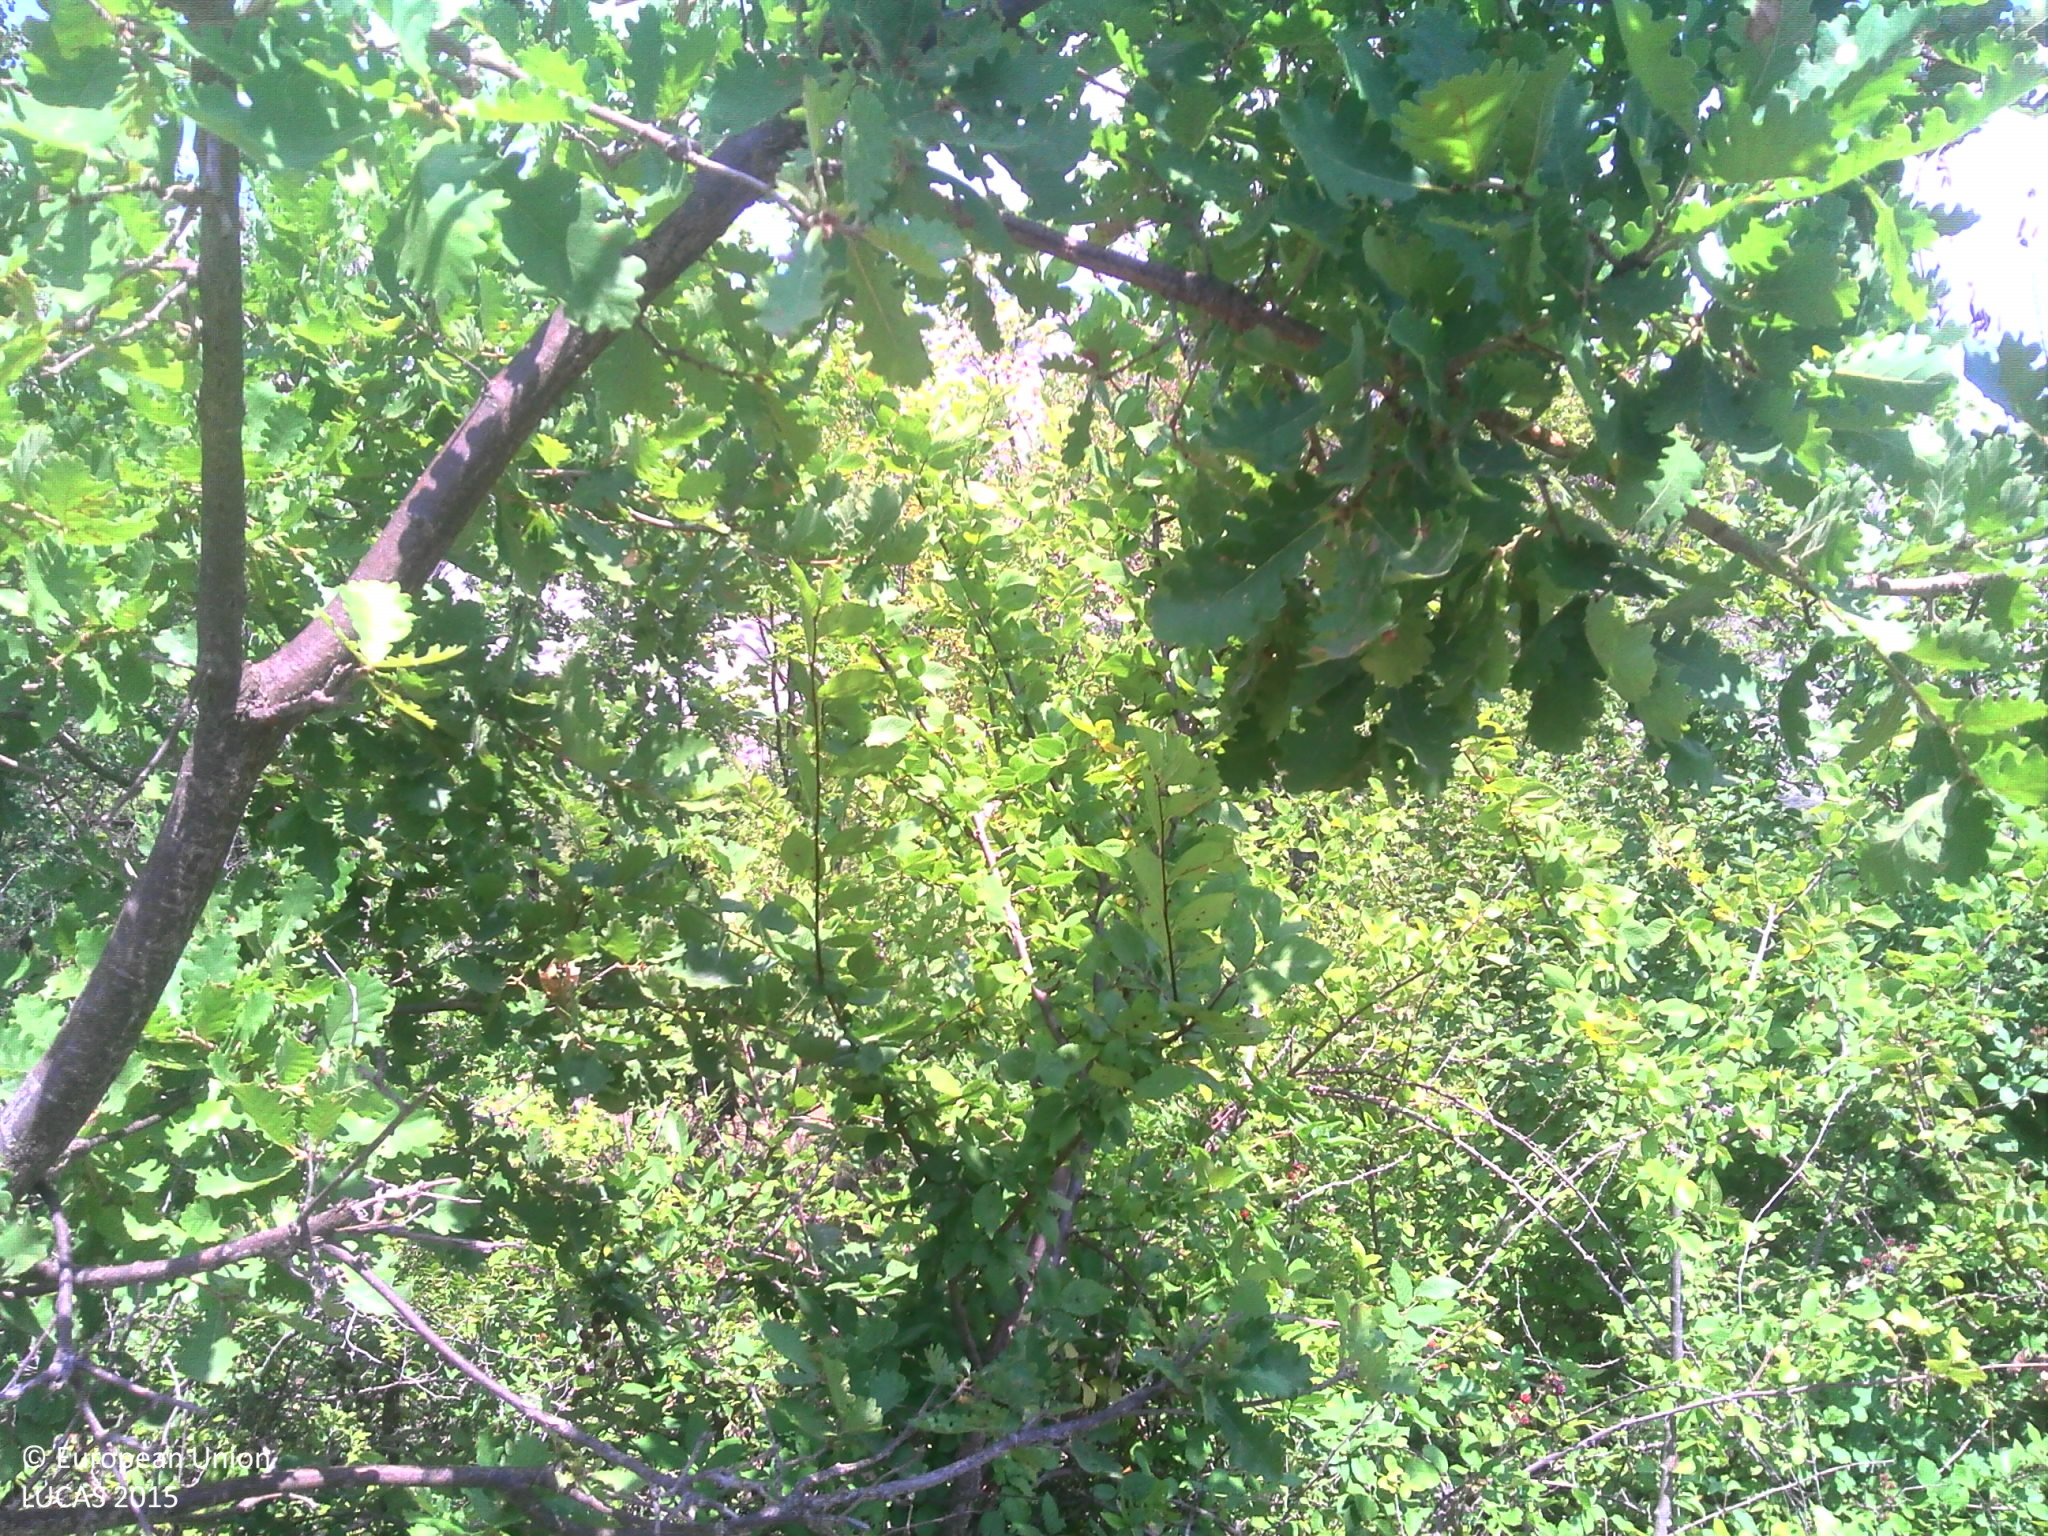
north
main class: Woodland
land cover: Broadleaved woodland
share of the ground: > 75 %
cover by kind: broadleaved forest trees 60 %, herbaceous plants 30 %, unconsolidated bare surface 10 %
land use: Forestry
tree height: > 5 m
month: August
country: FR
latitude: 43.5163
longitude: 5.5932
